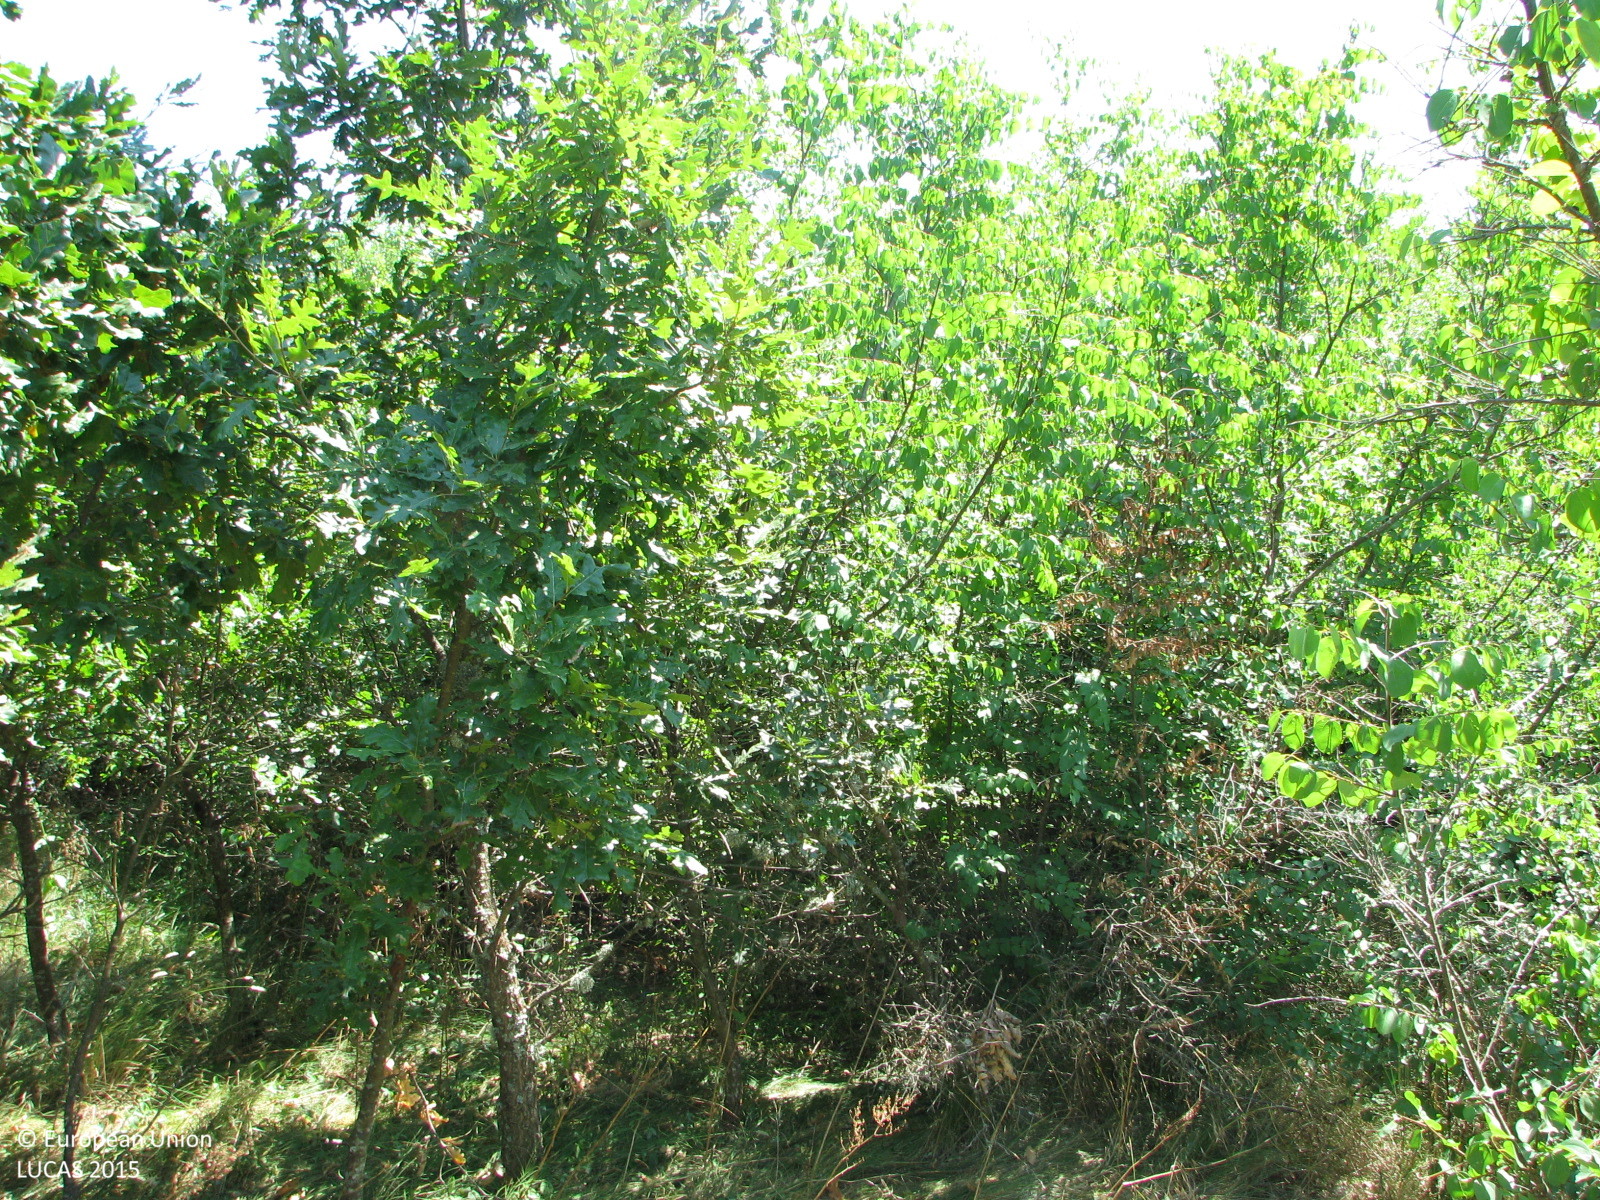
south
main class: Woodland
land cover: Broadleaved woodland
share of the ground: 10 - 25 %
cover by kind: shrubs 75 %, broadleaved forest trees 25 %
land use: Forestry
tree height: < 5 m
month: July
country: BG
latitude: 42.2144
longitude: 26.8004
